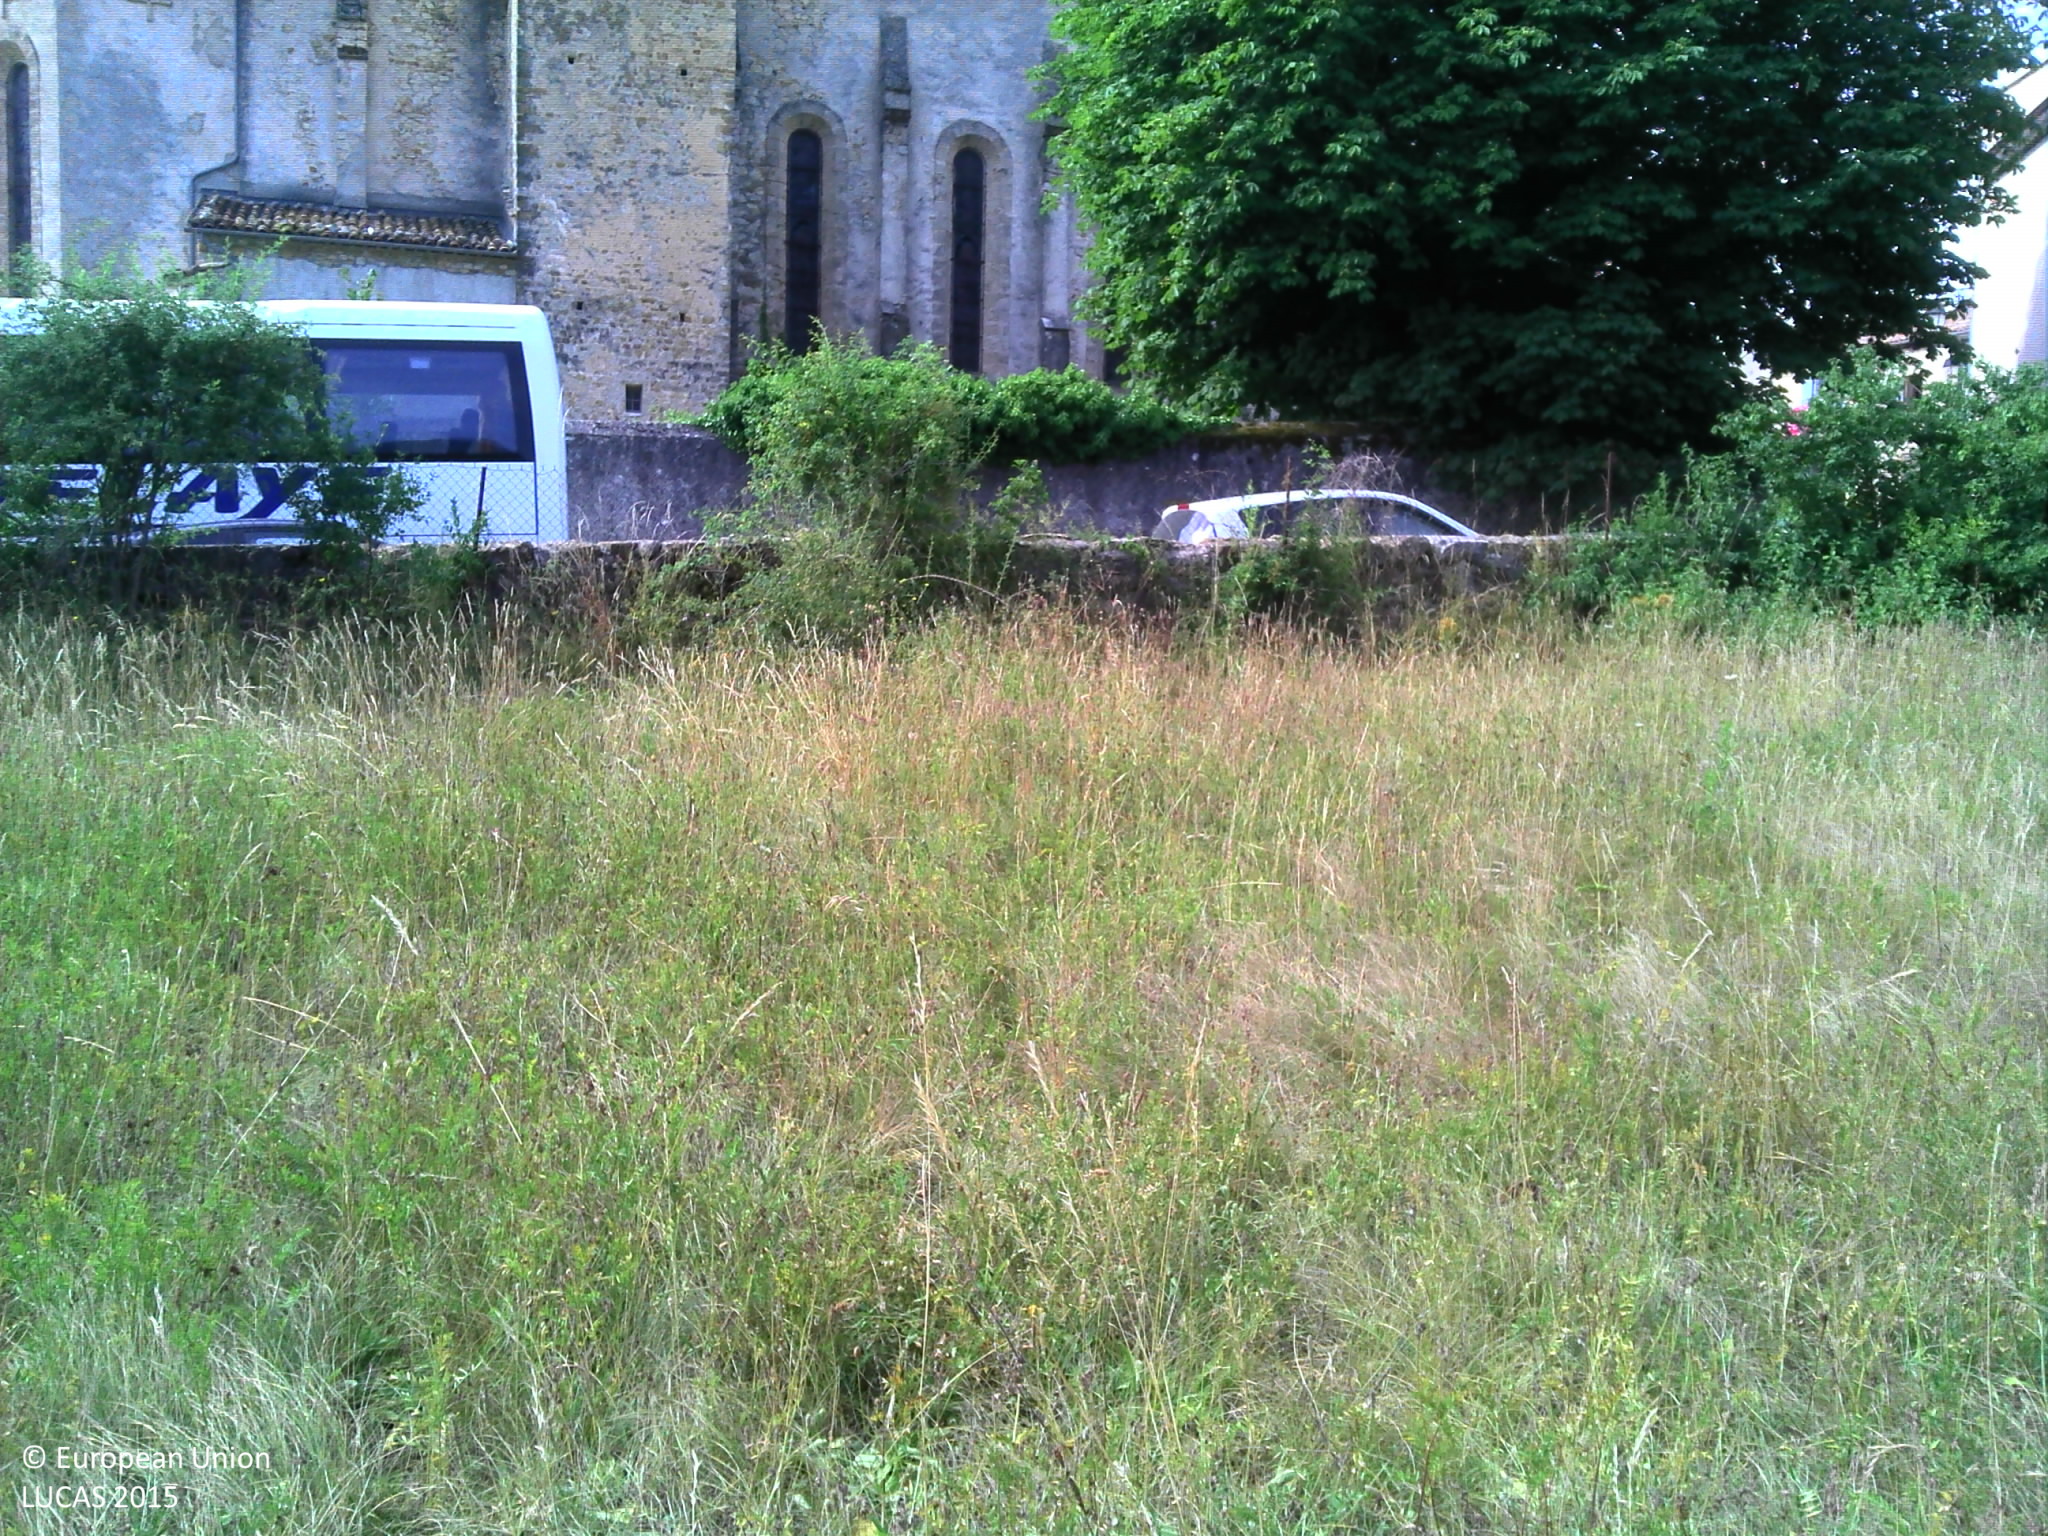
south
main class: Grassland
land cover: Grassland without tree/shrub cover
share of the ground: > 75 %
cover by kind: herbaceous plants 100 %
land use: Agriculture (excluding fallow land and kitchen gardens)
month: July
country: FR
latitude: 43.7805
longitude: 6.3427
